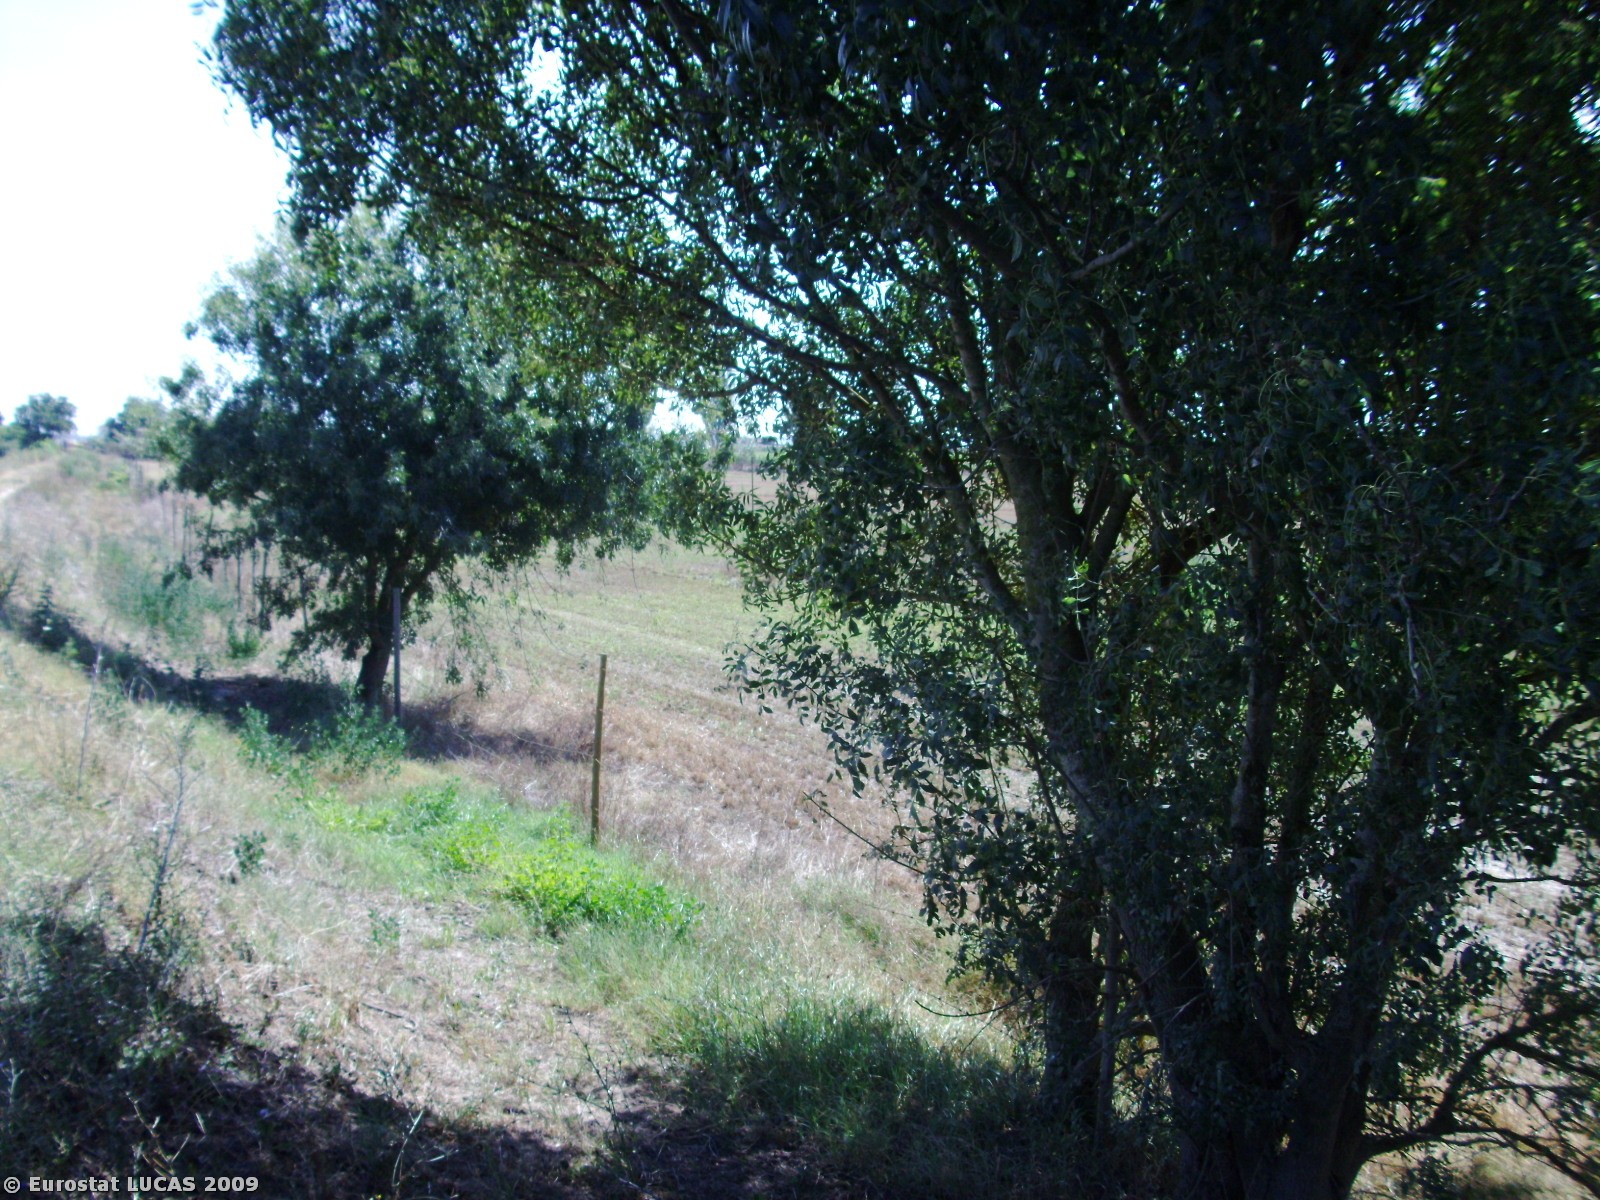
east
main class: Grassland
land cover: Grassland with sparse tree/shrub cover
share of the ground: 50 - 75 %
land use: Agriculture (excluding fallow land and kitchen gardens)
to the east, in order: Grassland with sparse tree/shrub cover; Artificial constructions in urban areas; Lines of trees; Spontaneously vegetated surfaces; Fences; Temporary grasslands; Fences; Grass margins; Tracks; Tomatoes
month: August
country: PT
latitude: 39.0423
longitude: -8.8004
